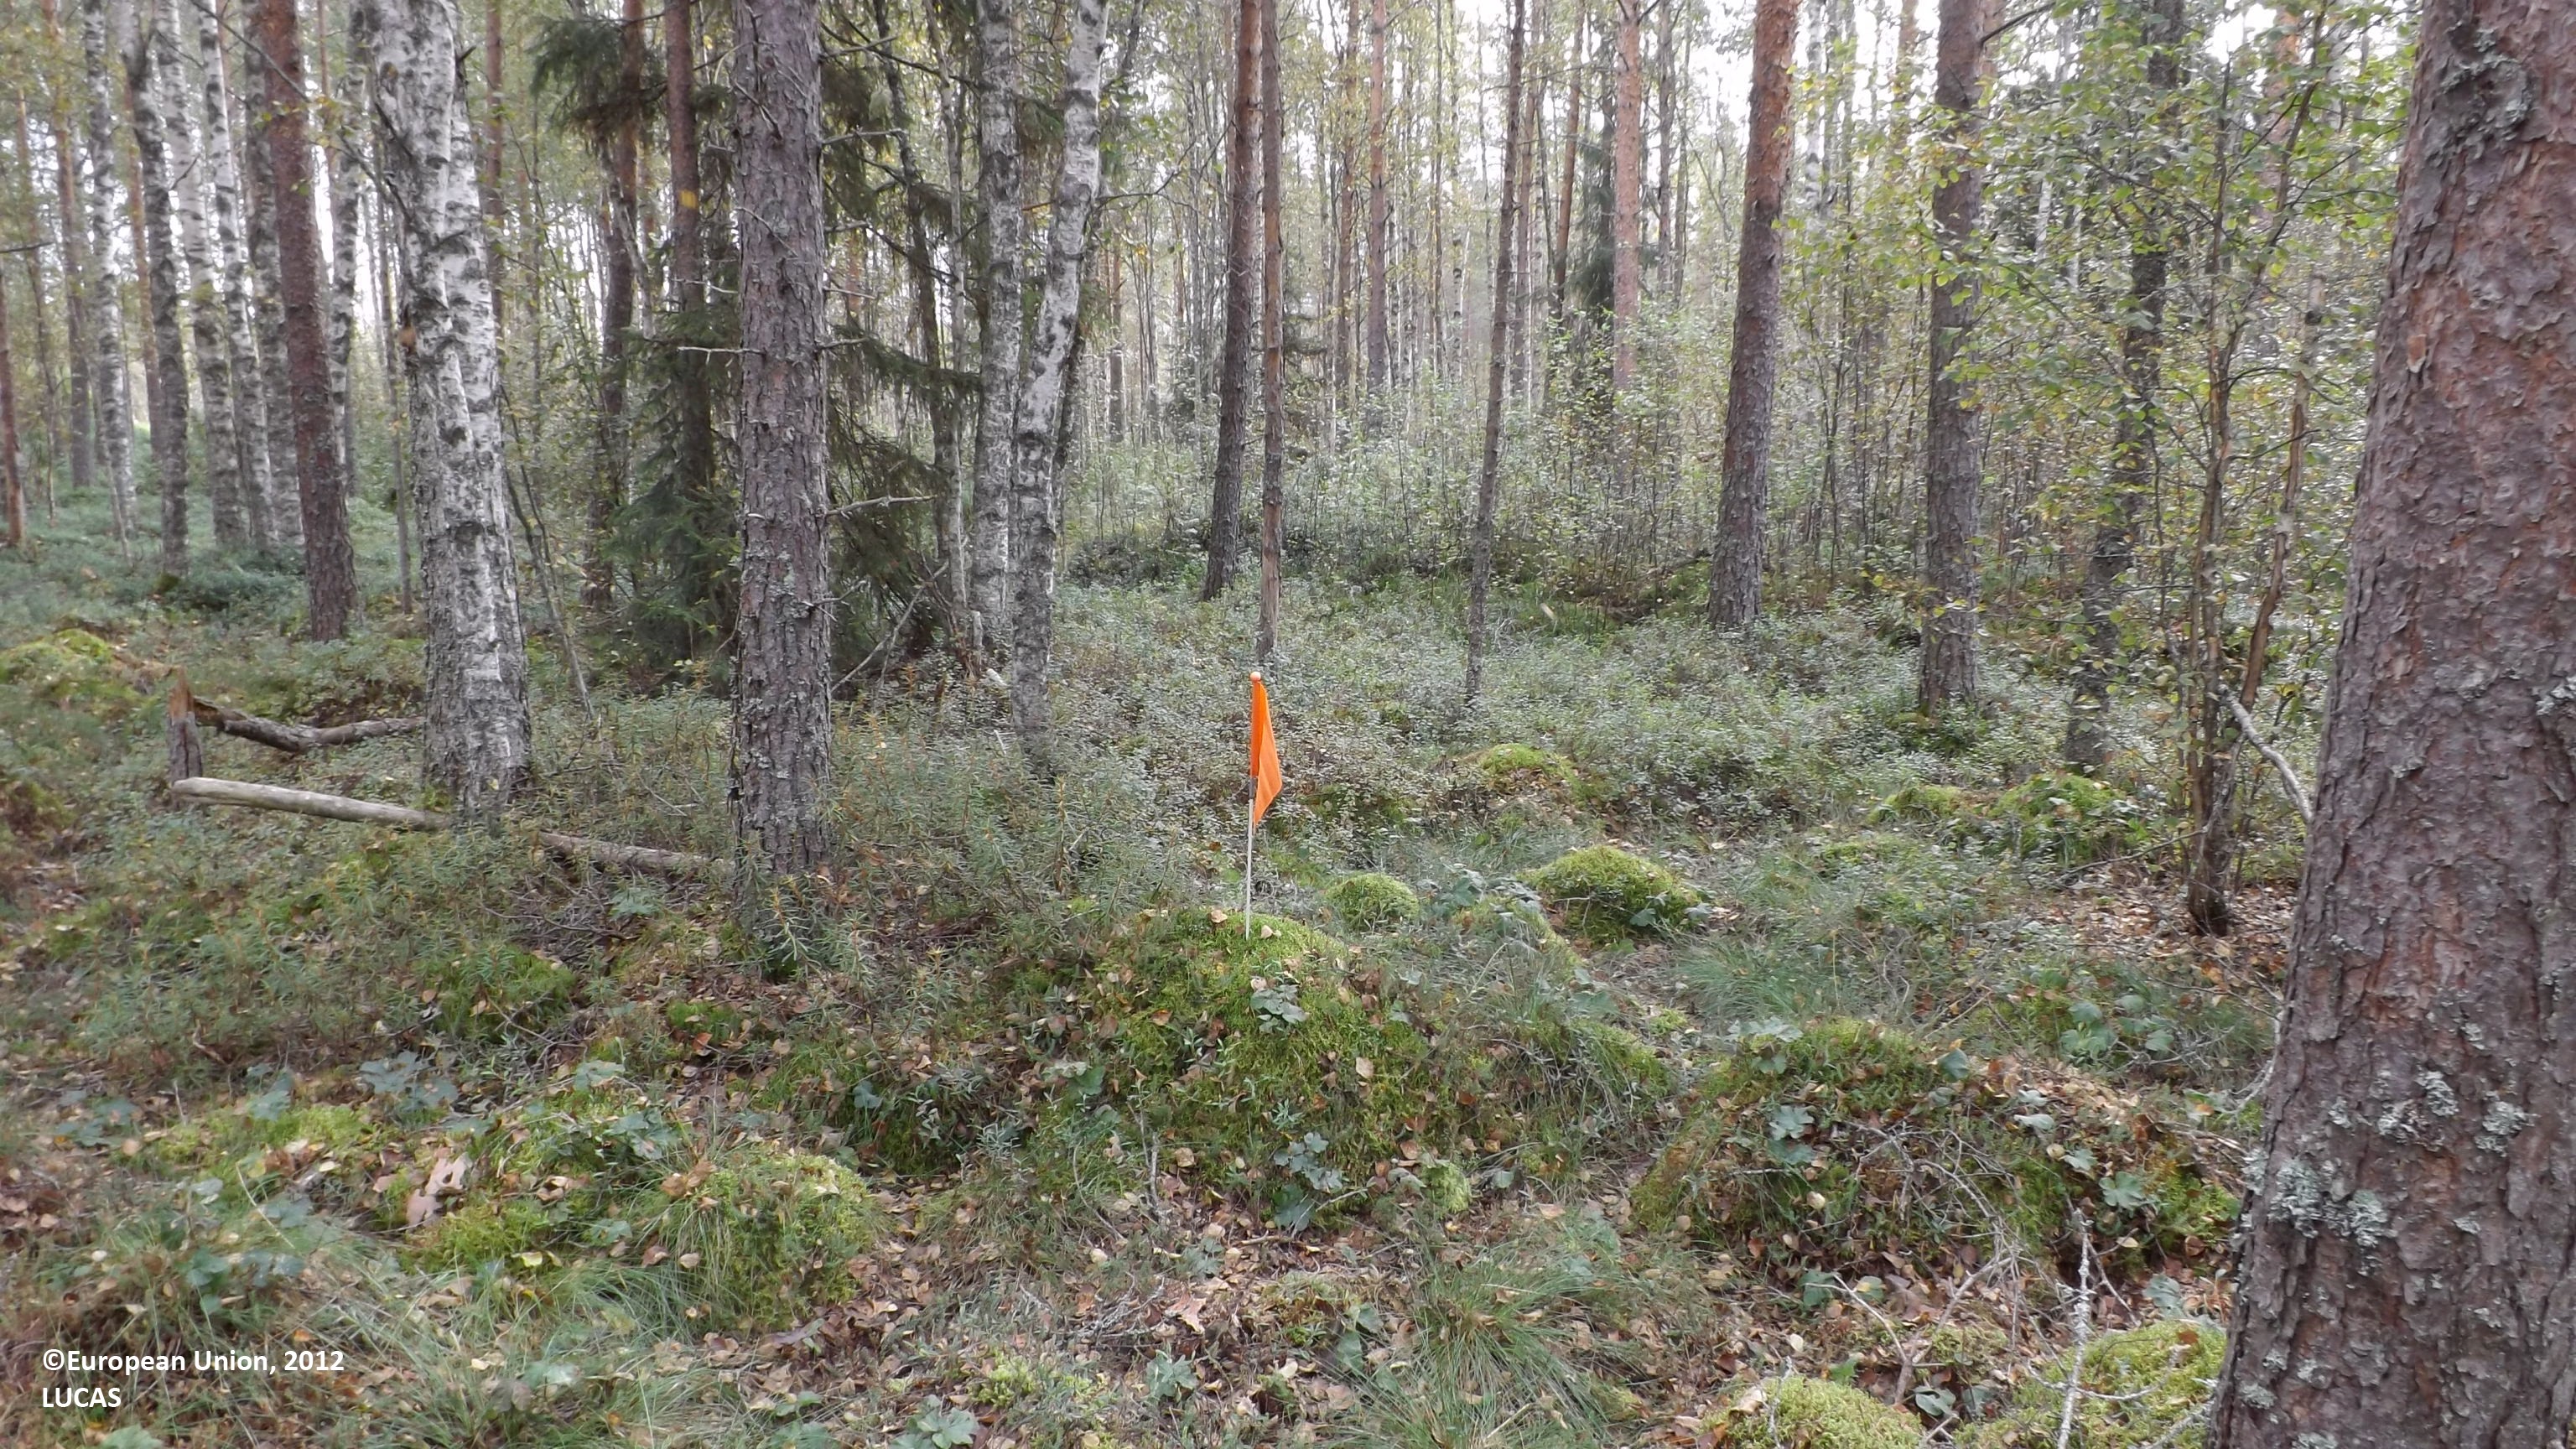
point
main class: Woodland
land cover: Pine dominated mixed woodland
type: boreal forest
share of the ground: 50 - 75 %
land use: Forestry
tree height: > 5 m
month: August
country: FI
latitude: 63.7419
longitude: 23.7385
